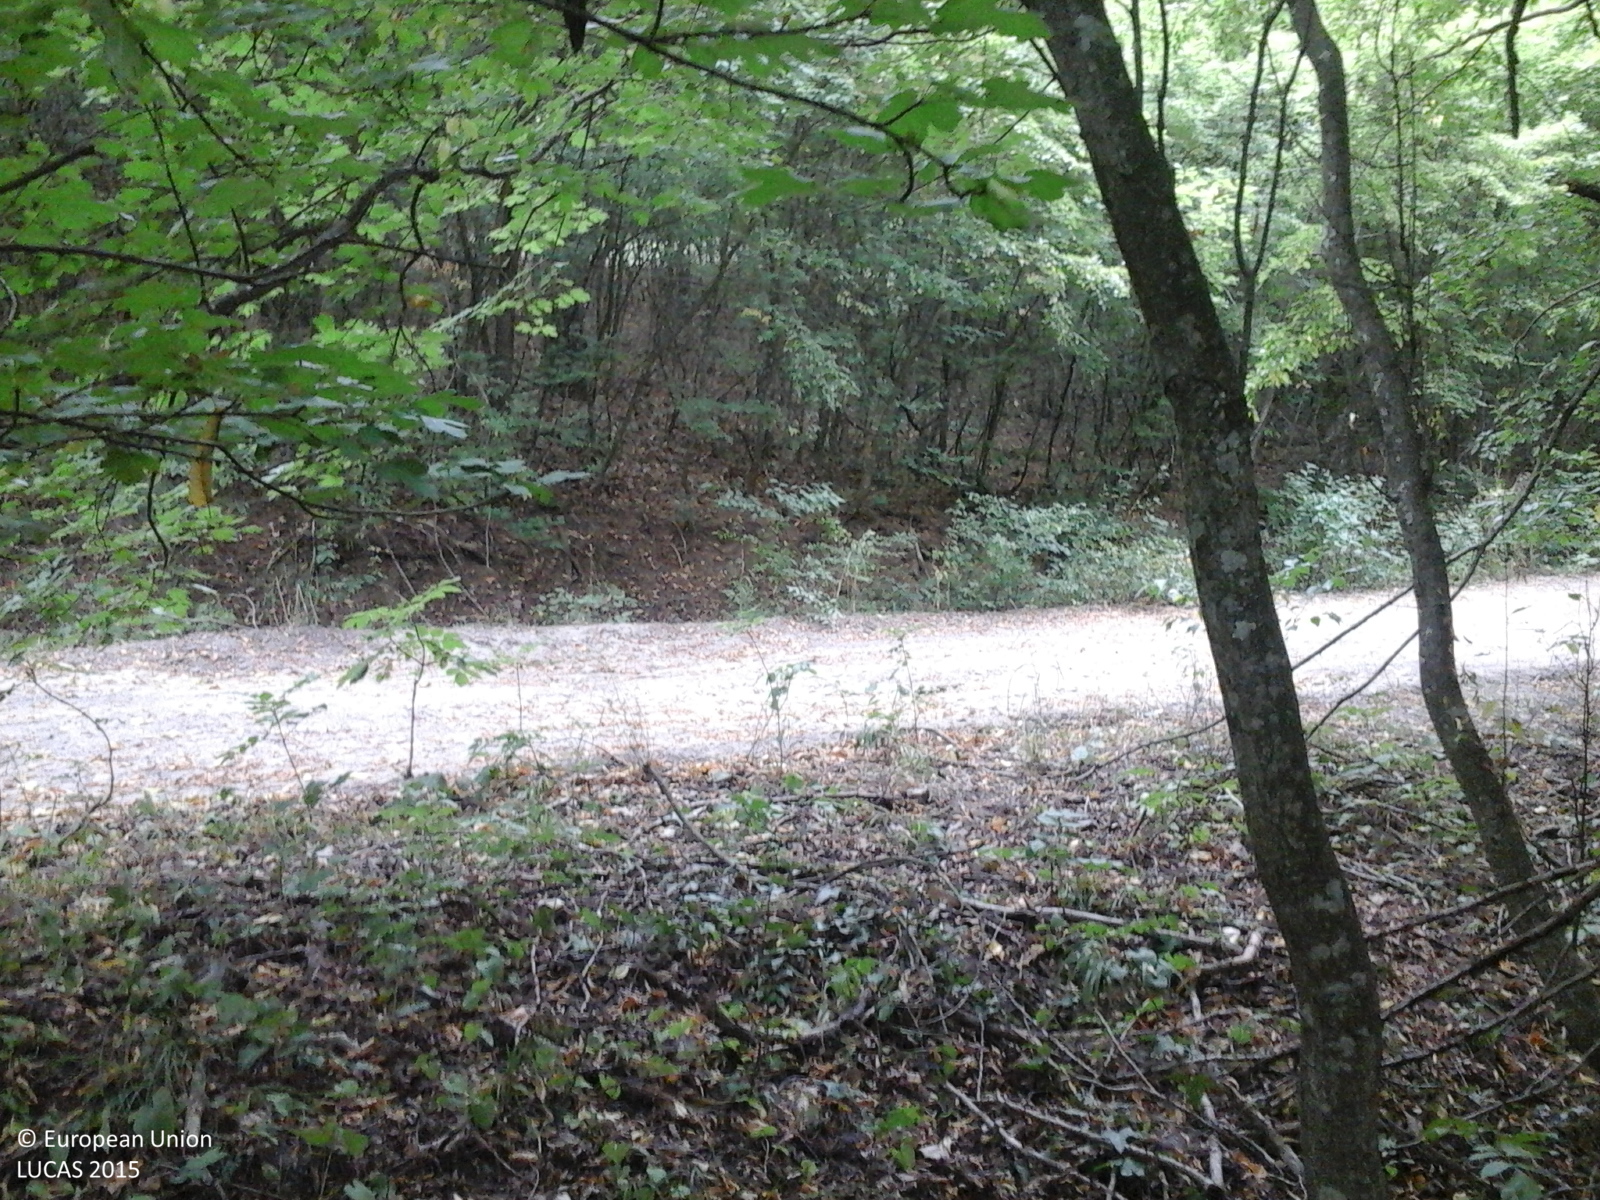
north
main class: Woodland
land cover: Broadleaved woodland
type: beech forest
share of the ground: > 75 %
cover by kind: broadleaved forest trees 100 %
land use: Forestry
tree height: > 5 m
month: July
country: RO
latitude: 44.8676
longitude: 28.5969
